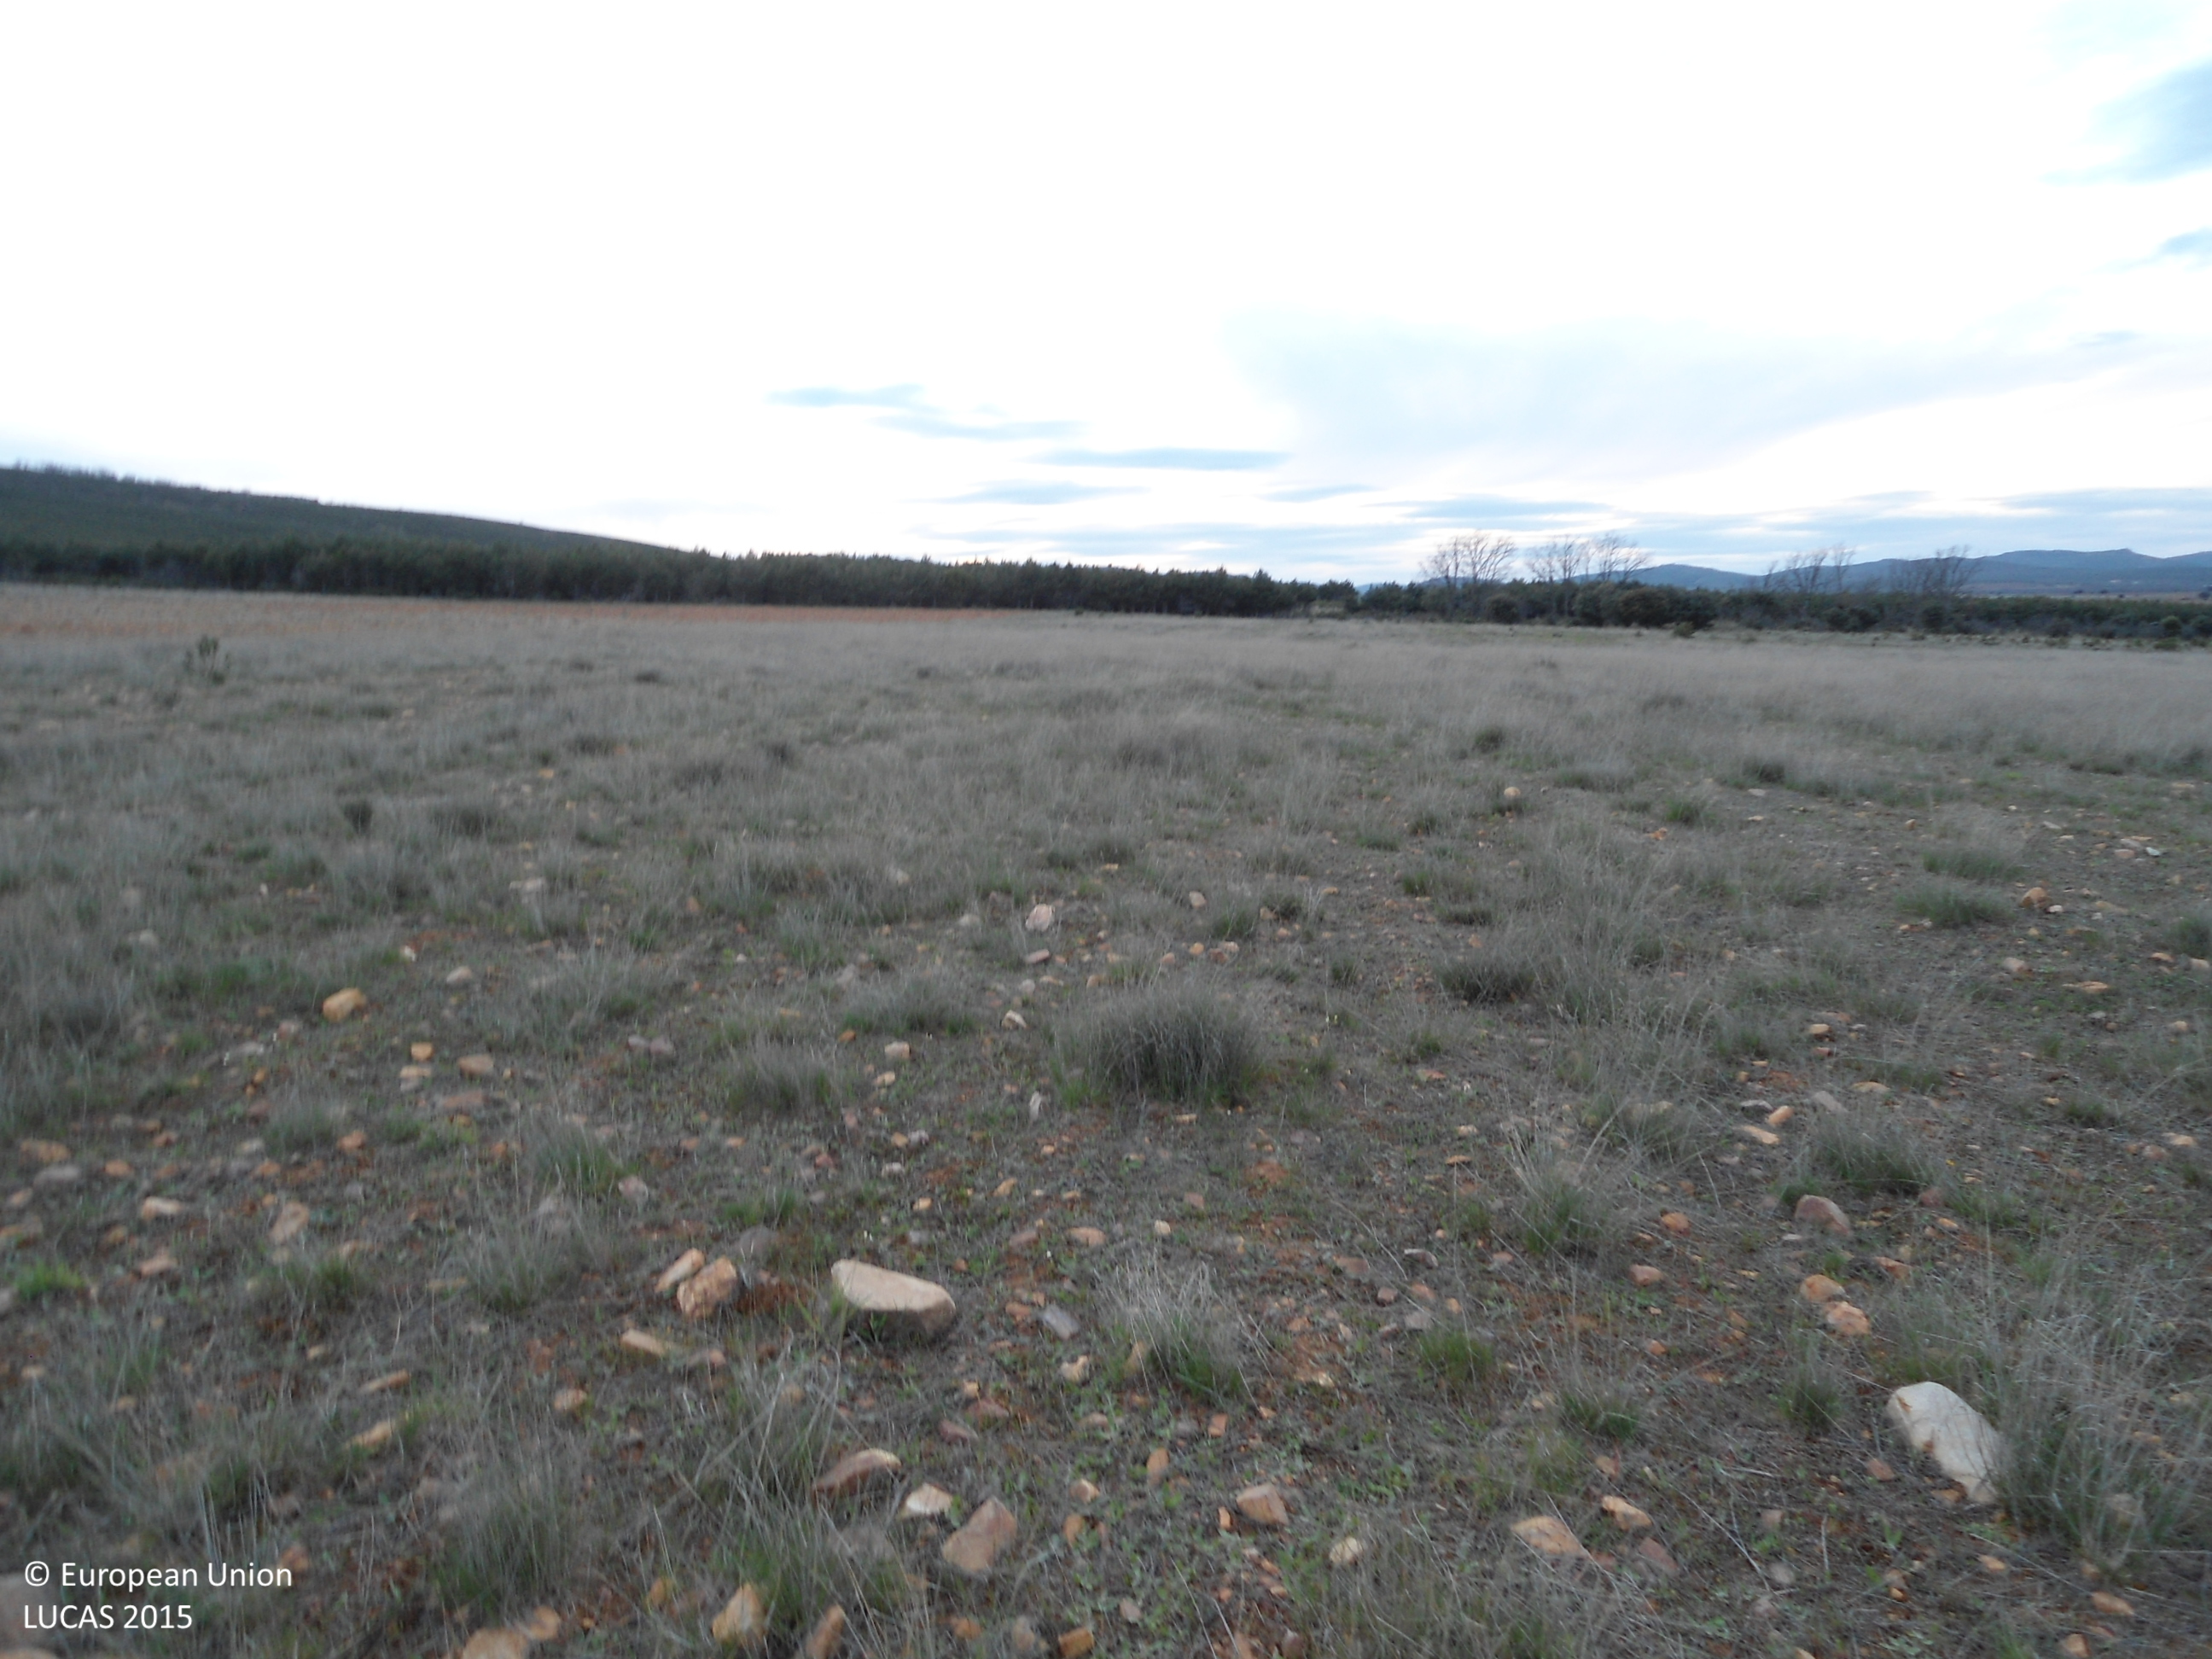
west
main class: Grassland
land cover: Spontaneously vegetated surfaces
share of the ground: > 75 %
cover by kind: herbaceous plants 100 %
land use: Agriculture (excluding fallow land and kitchen gardens)
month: April
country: ES
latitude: 41.7862
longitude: -5.9414
